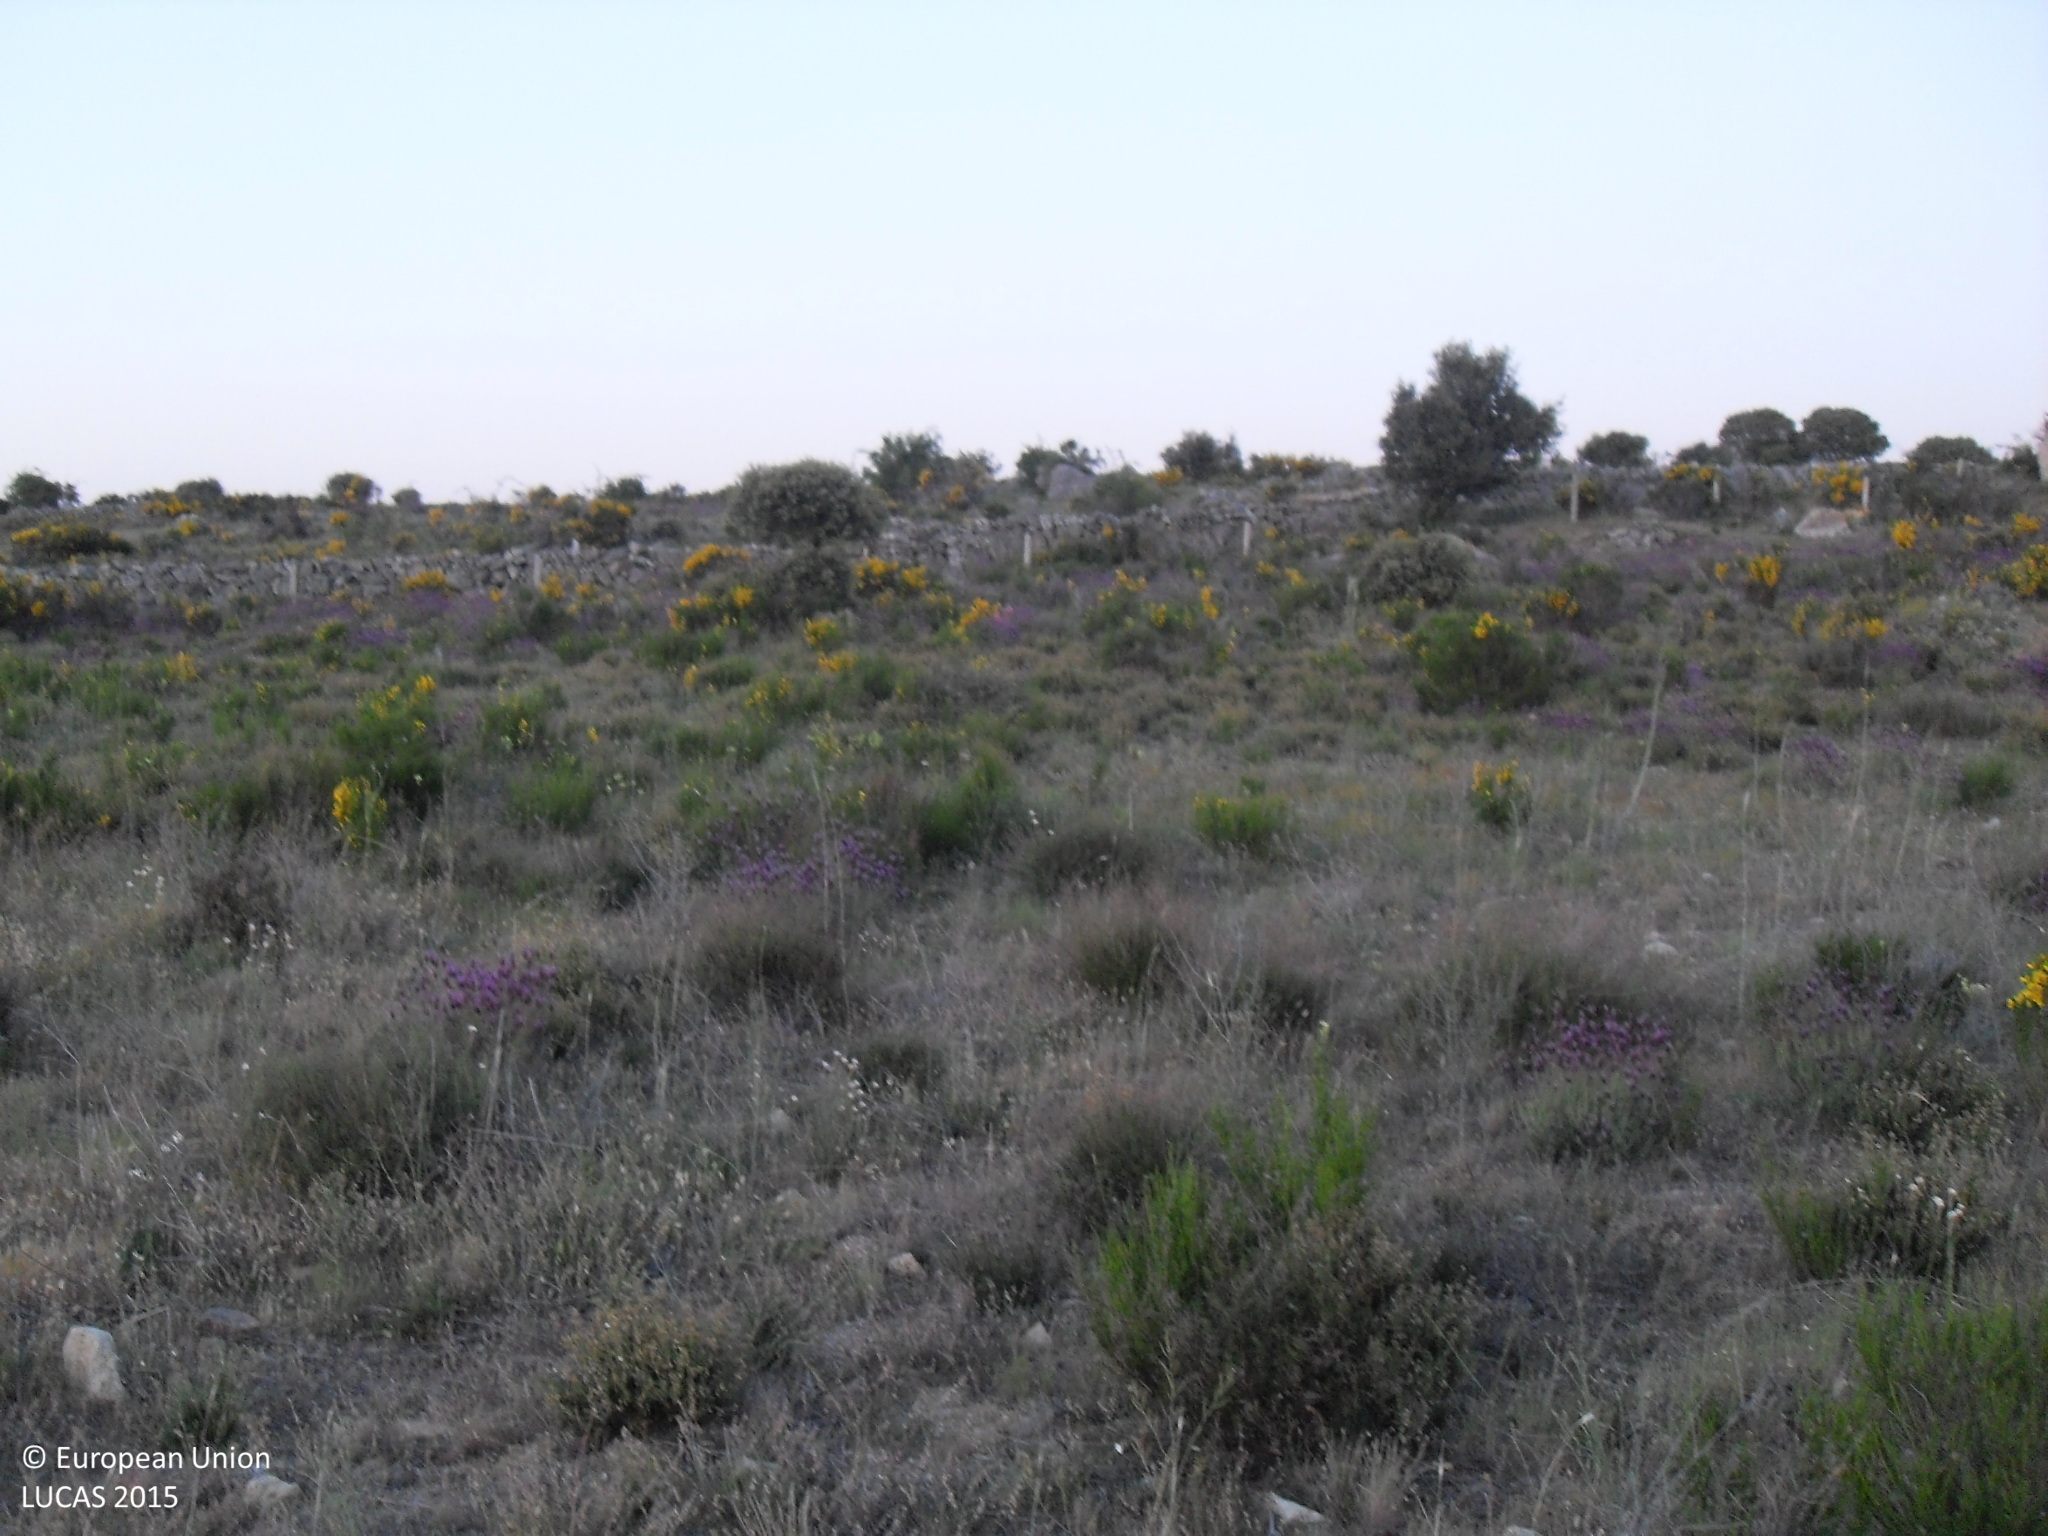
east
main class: Grassland
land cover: Grassland without tree/shrub cover
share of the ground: > 75 %
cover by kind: herbaceous plants 100 %
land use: Agriculture (excluding fallow land and kitchen gardens)
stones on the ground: < 10 %
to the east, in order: Grassland without tree/shrub cover; Fences; Grass margins; Tracks; Grass margins; Dry stone walls; Shrubland without tree cover; Dry stone walls; Shrubland without tree cover
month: May
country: ES
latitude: 40.5674
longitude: -5.2896
